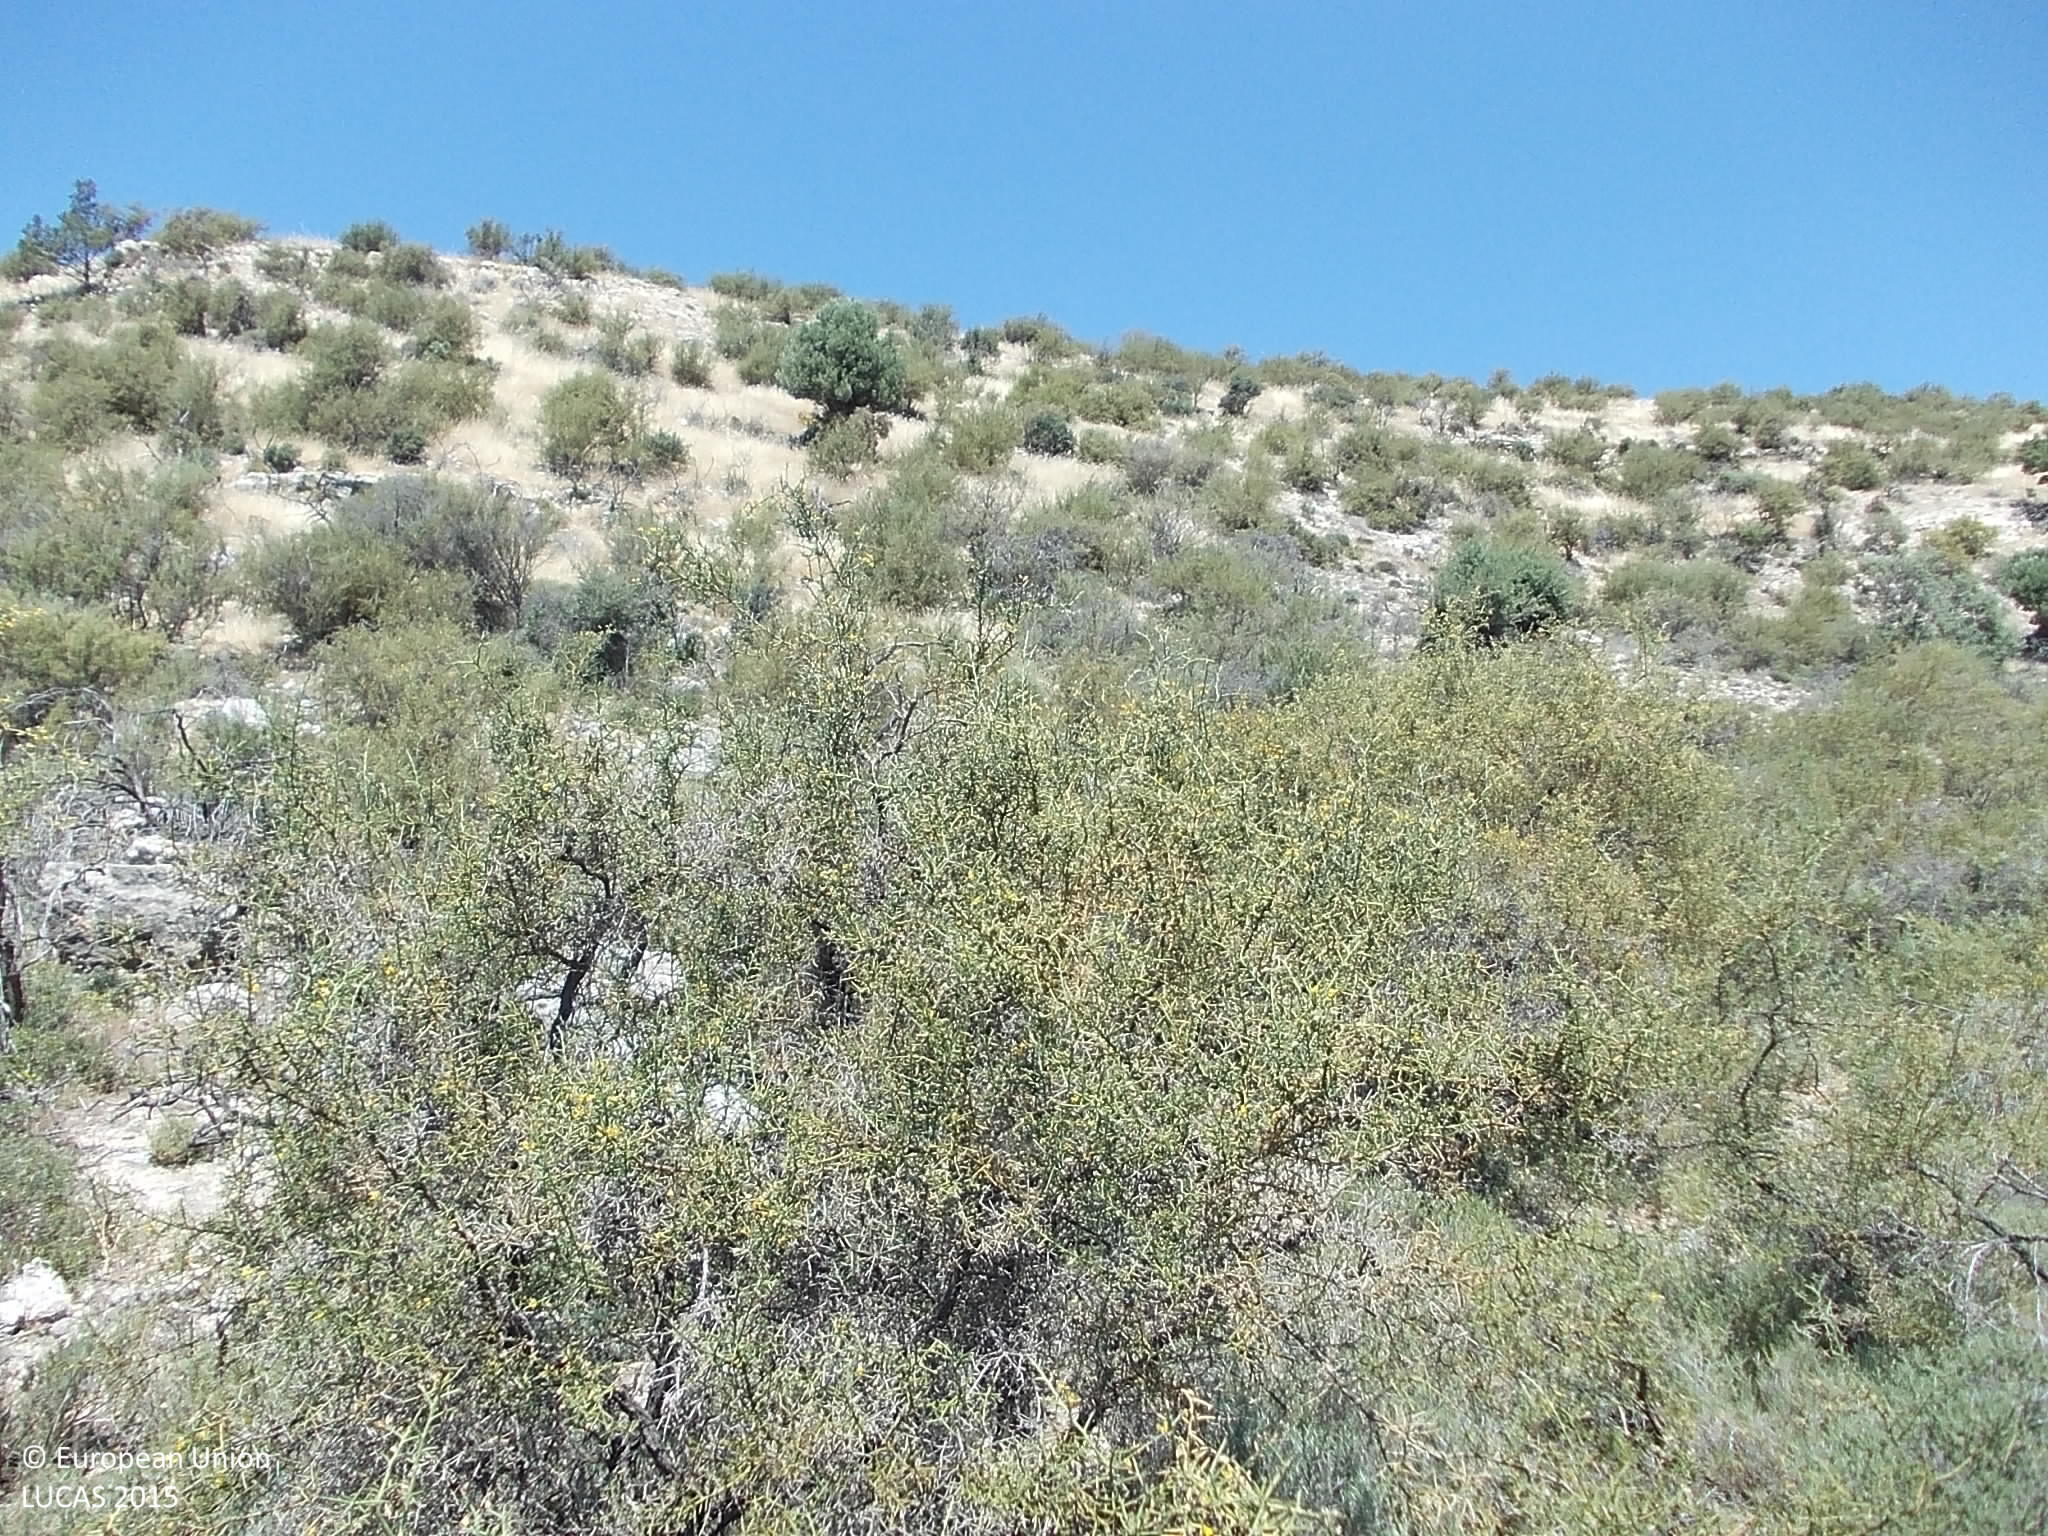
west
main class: Shrubland
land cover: Shrubland without tree cover
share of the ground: > 75 %
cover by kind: shrubs 80 %, unconsolidated bare surface 20 %
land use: Semi-natural and natural areas not in use
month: May
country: CY
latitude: 34.6984
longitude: 32.7862
